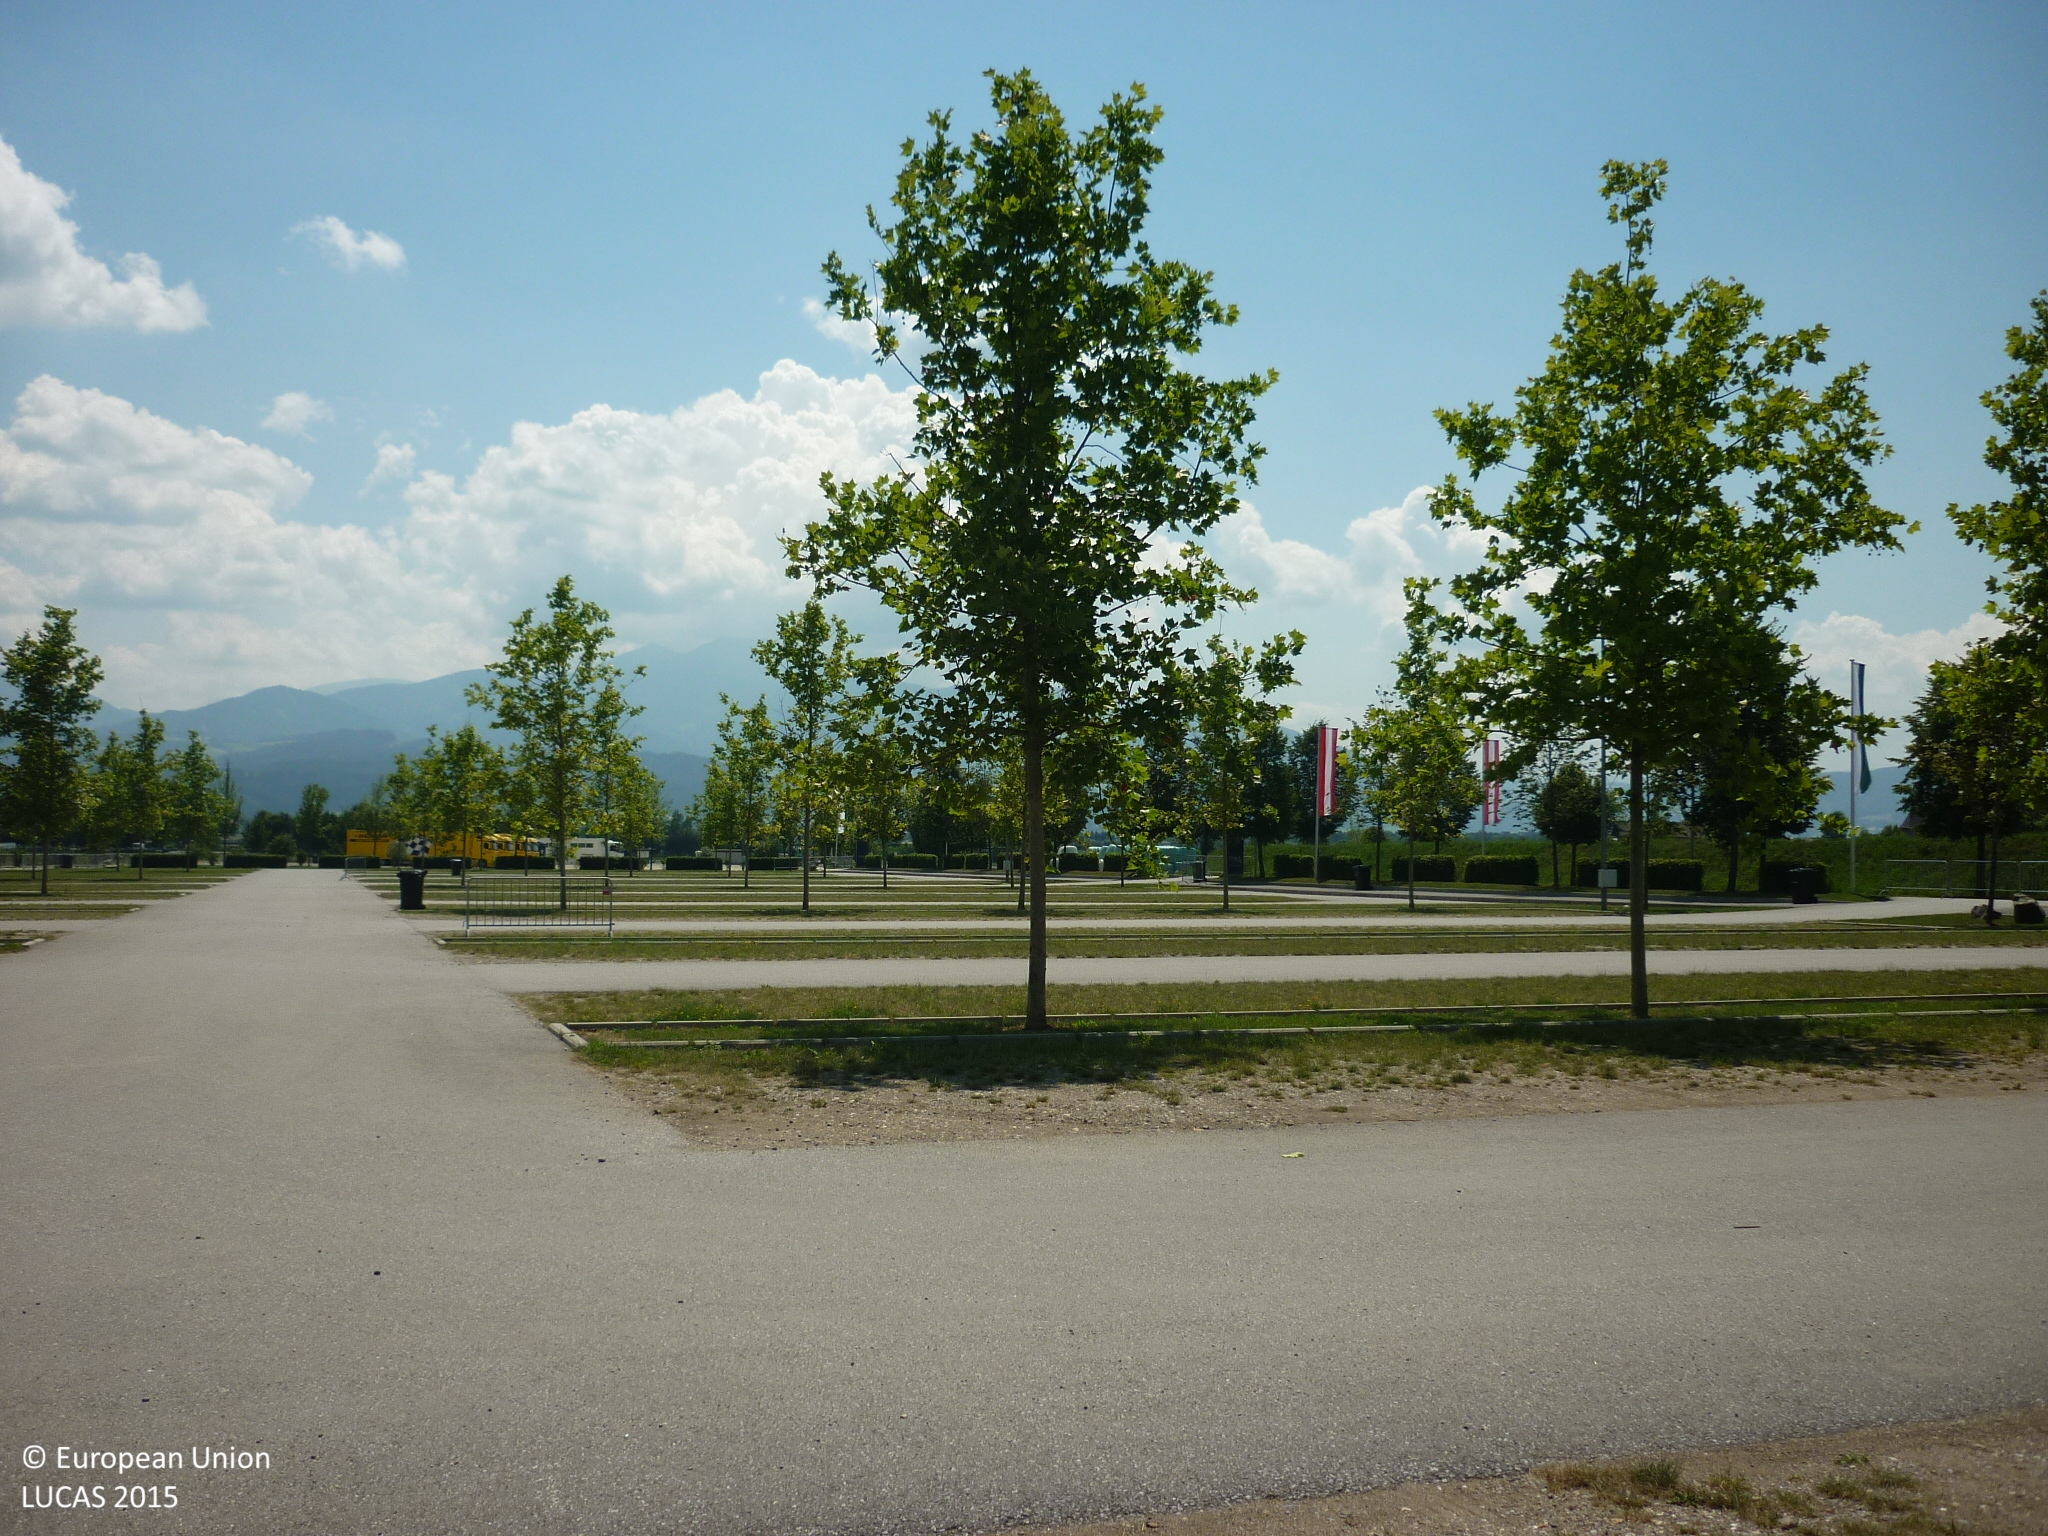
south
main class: Grassland
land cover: Grassland with sparse tree/shrub cover
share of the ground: > 75 %
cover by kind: herbaceous plants 95 %, broadleaved forest trees 5 %
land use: Road transport
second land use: Amenities, museums, leisure
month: July
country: AT
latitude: 47.2190
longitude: 14.7661
